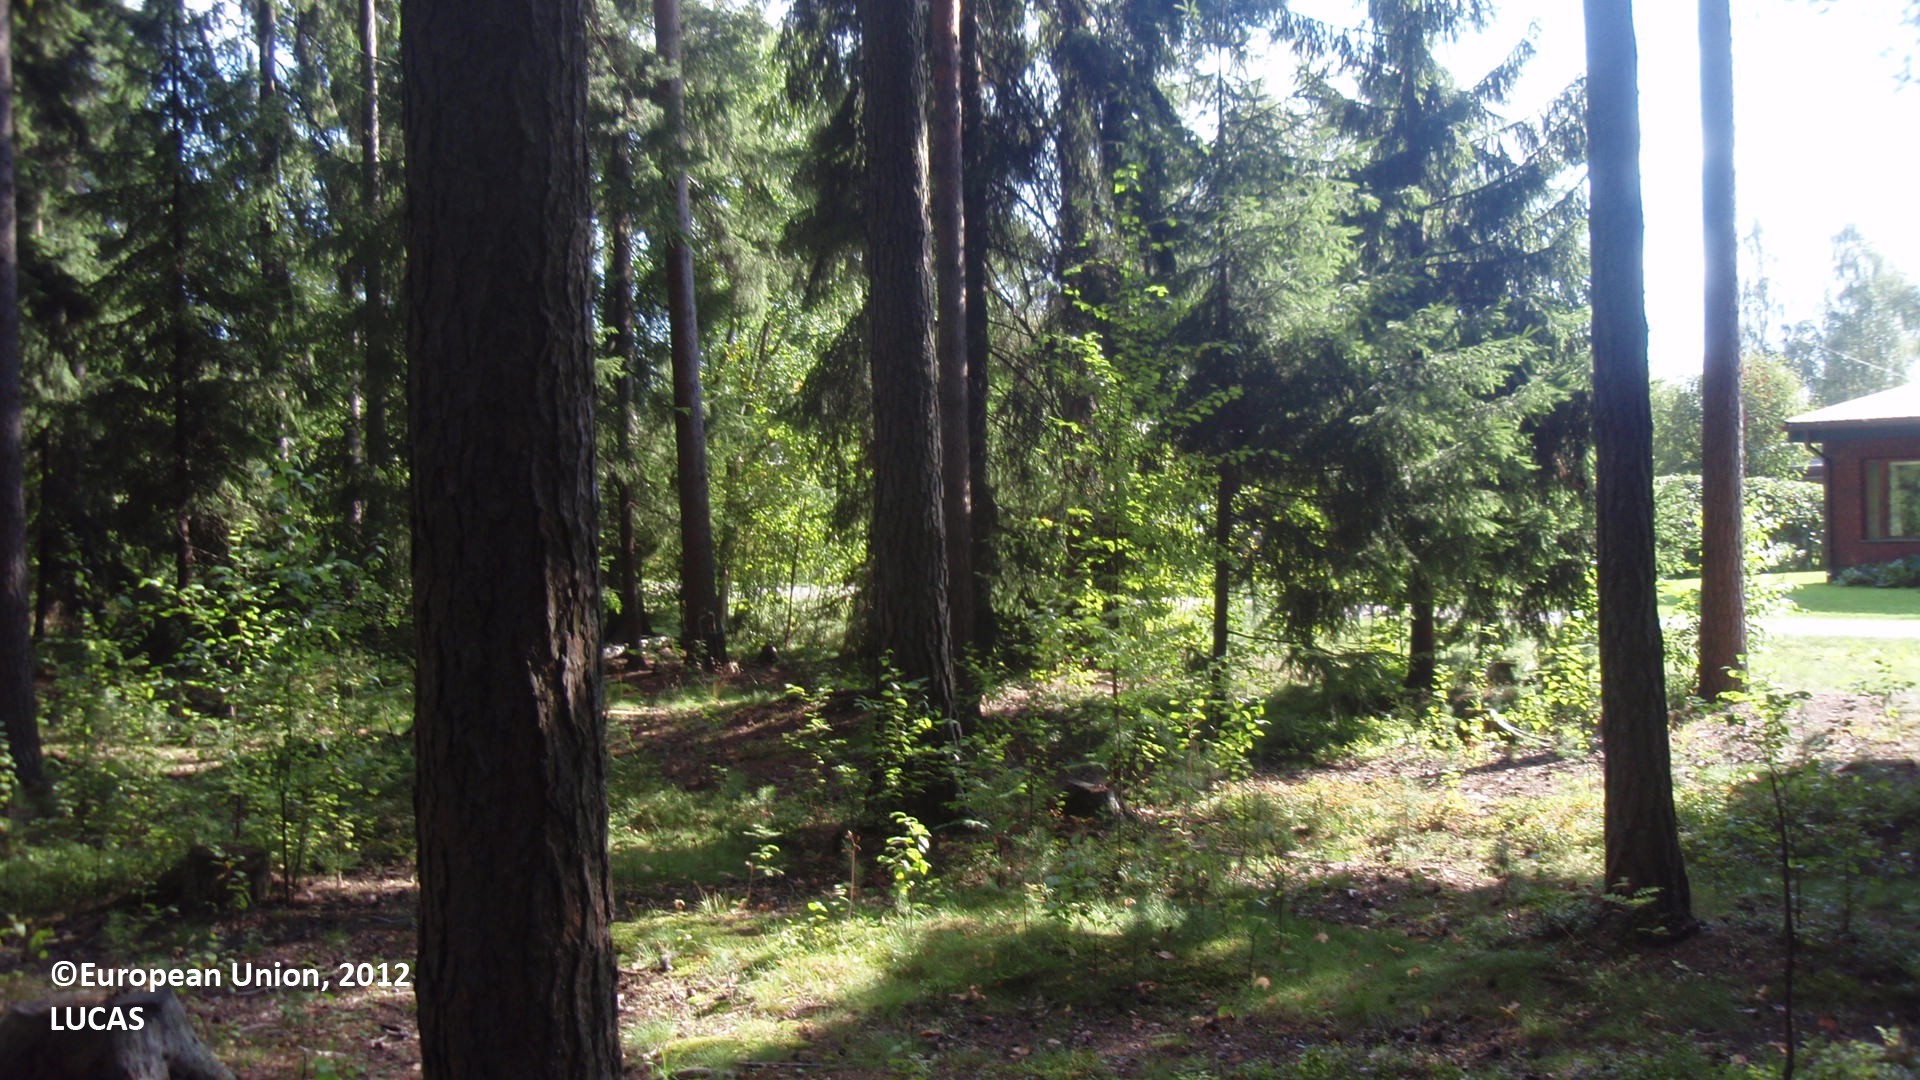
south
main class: Woodland
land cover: Spruce dominated mixed woodland
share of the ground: 50 - 75 %
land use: Forestry
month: August
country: FI
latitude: 60.8494
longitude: 26.5904
